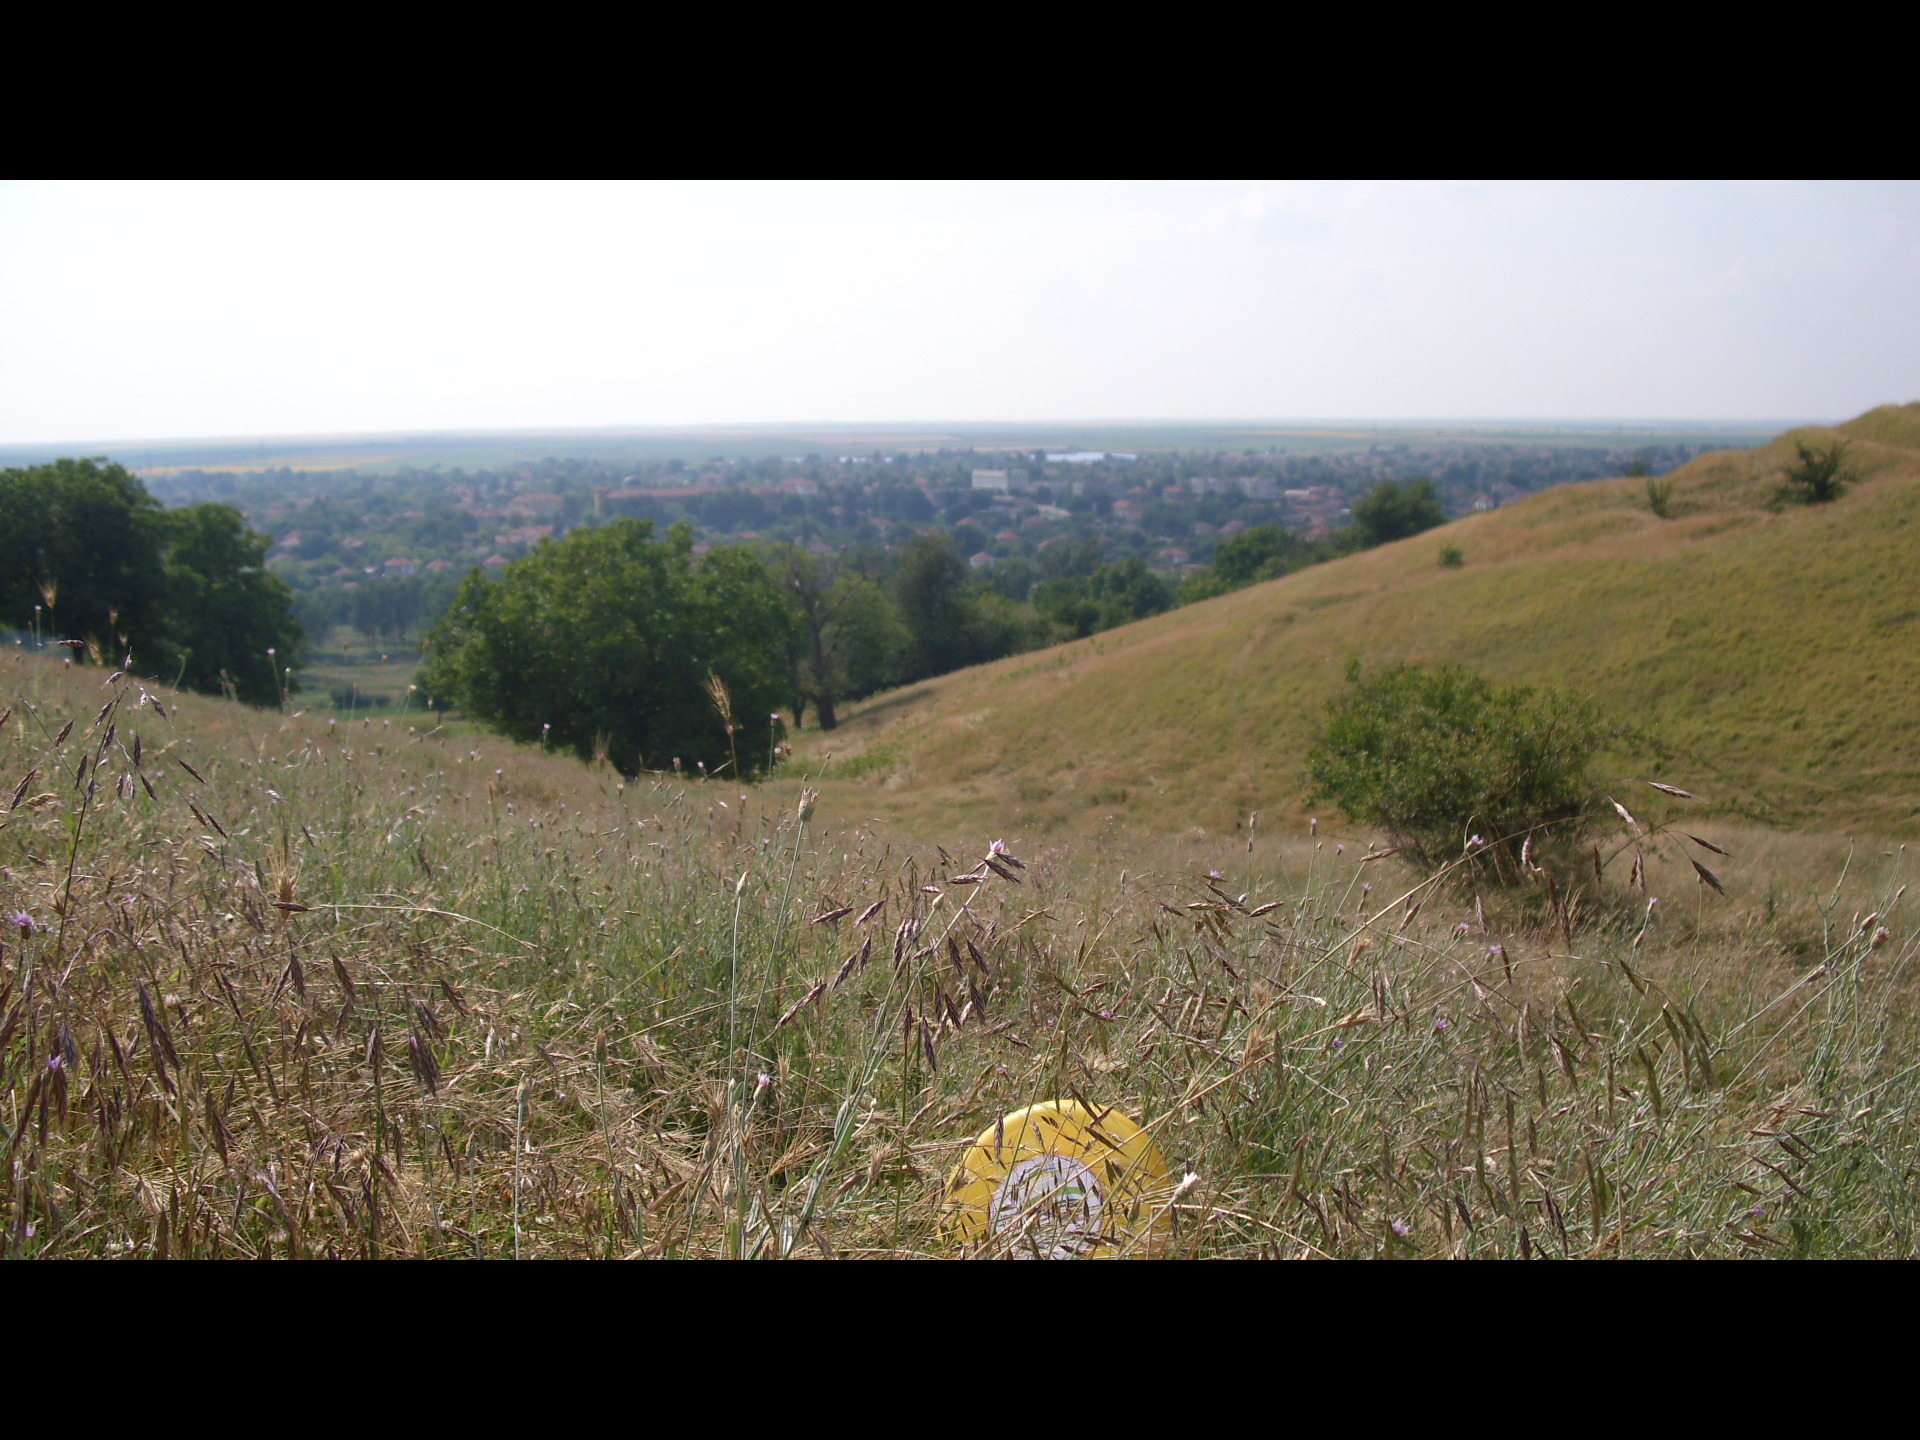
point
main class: Grassland
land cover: Grassland without tree/shrub cover
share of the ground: > 75 %
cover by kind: herbaceous plants 100 %
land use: Agriculture (excluding fallow land and kitchen gardens)
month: June
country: BG
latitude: 43.6887
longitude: 23.4567
